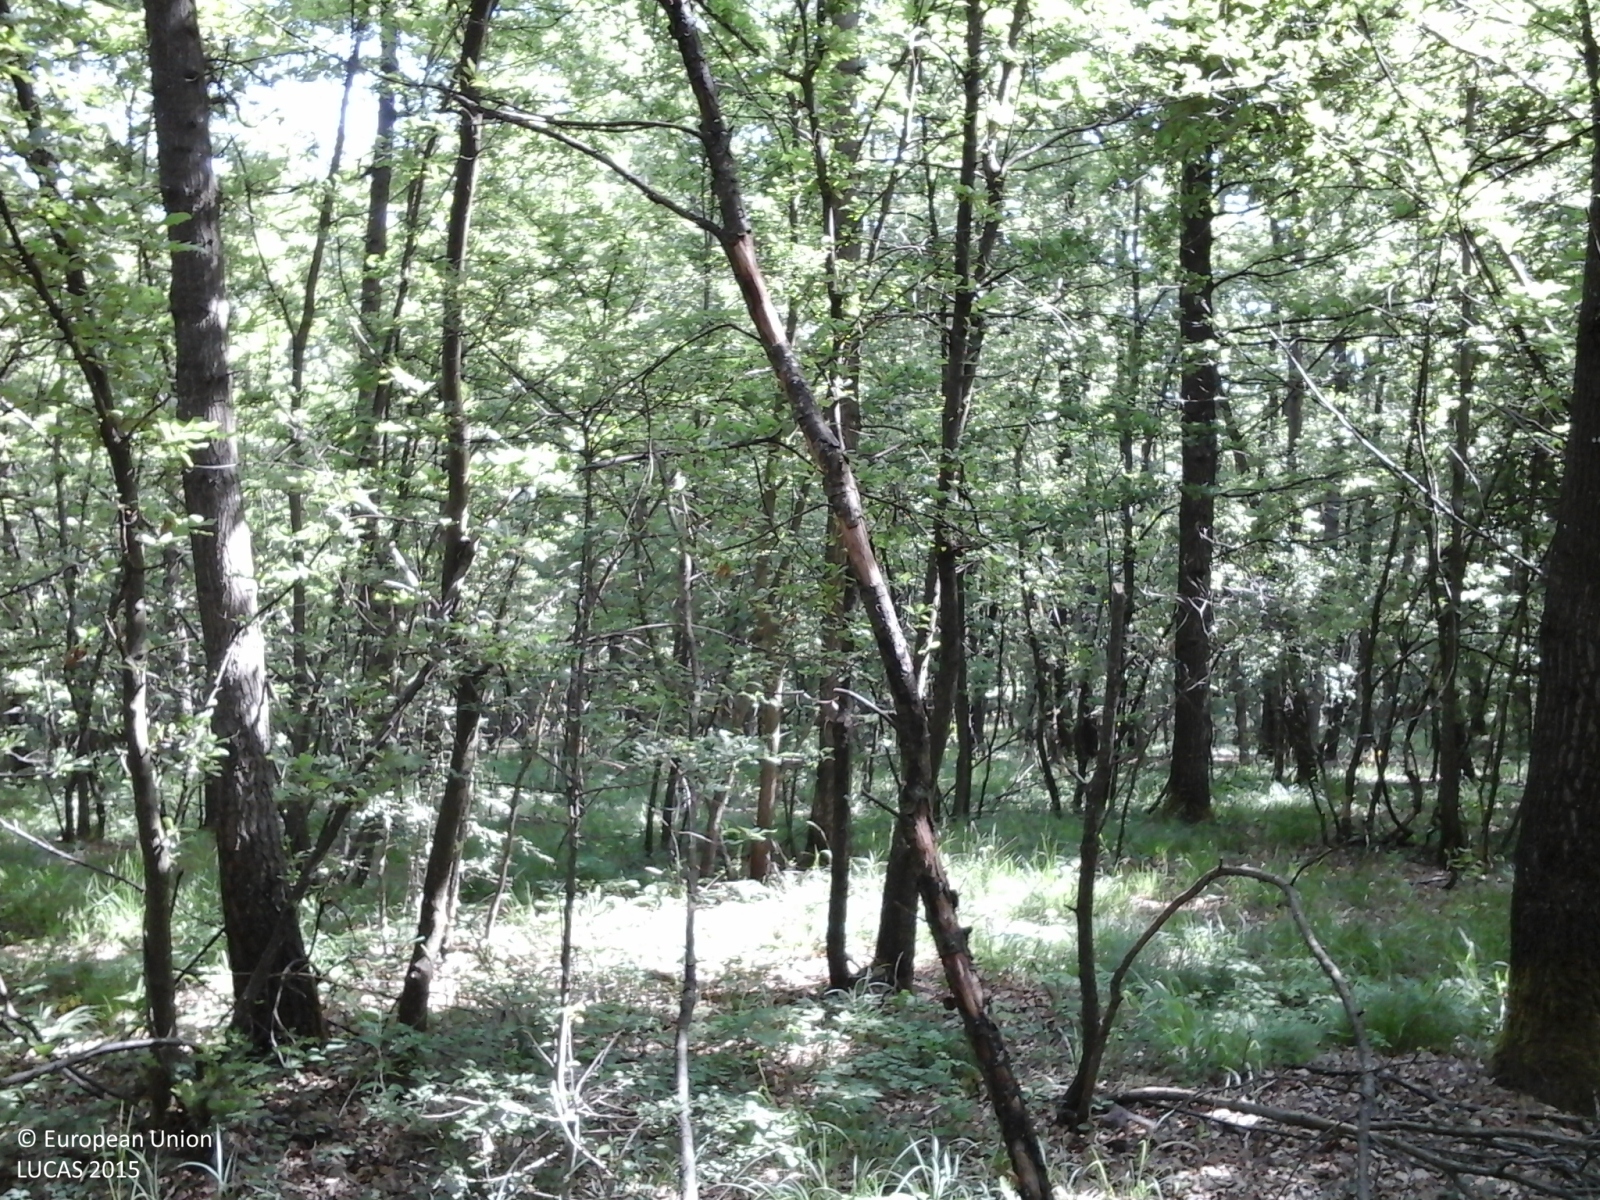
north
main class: Woodland
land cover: Broadleaved woodland
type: thermophilous deciduous forest
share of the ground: > 75 %
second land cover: Grassland without tree/shrub cover
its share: 50 - 75 %
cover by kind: broadleaved forest trees 100 %
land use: Forestry
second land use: Agriculture (excluding fallow land and kitchen gardens)
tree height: > 5 m
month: May
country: IT
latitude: 44.4202
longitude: 10.7143
